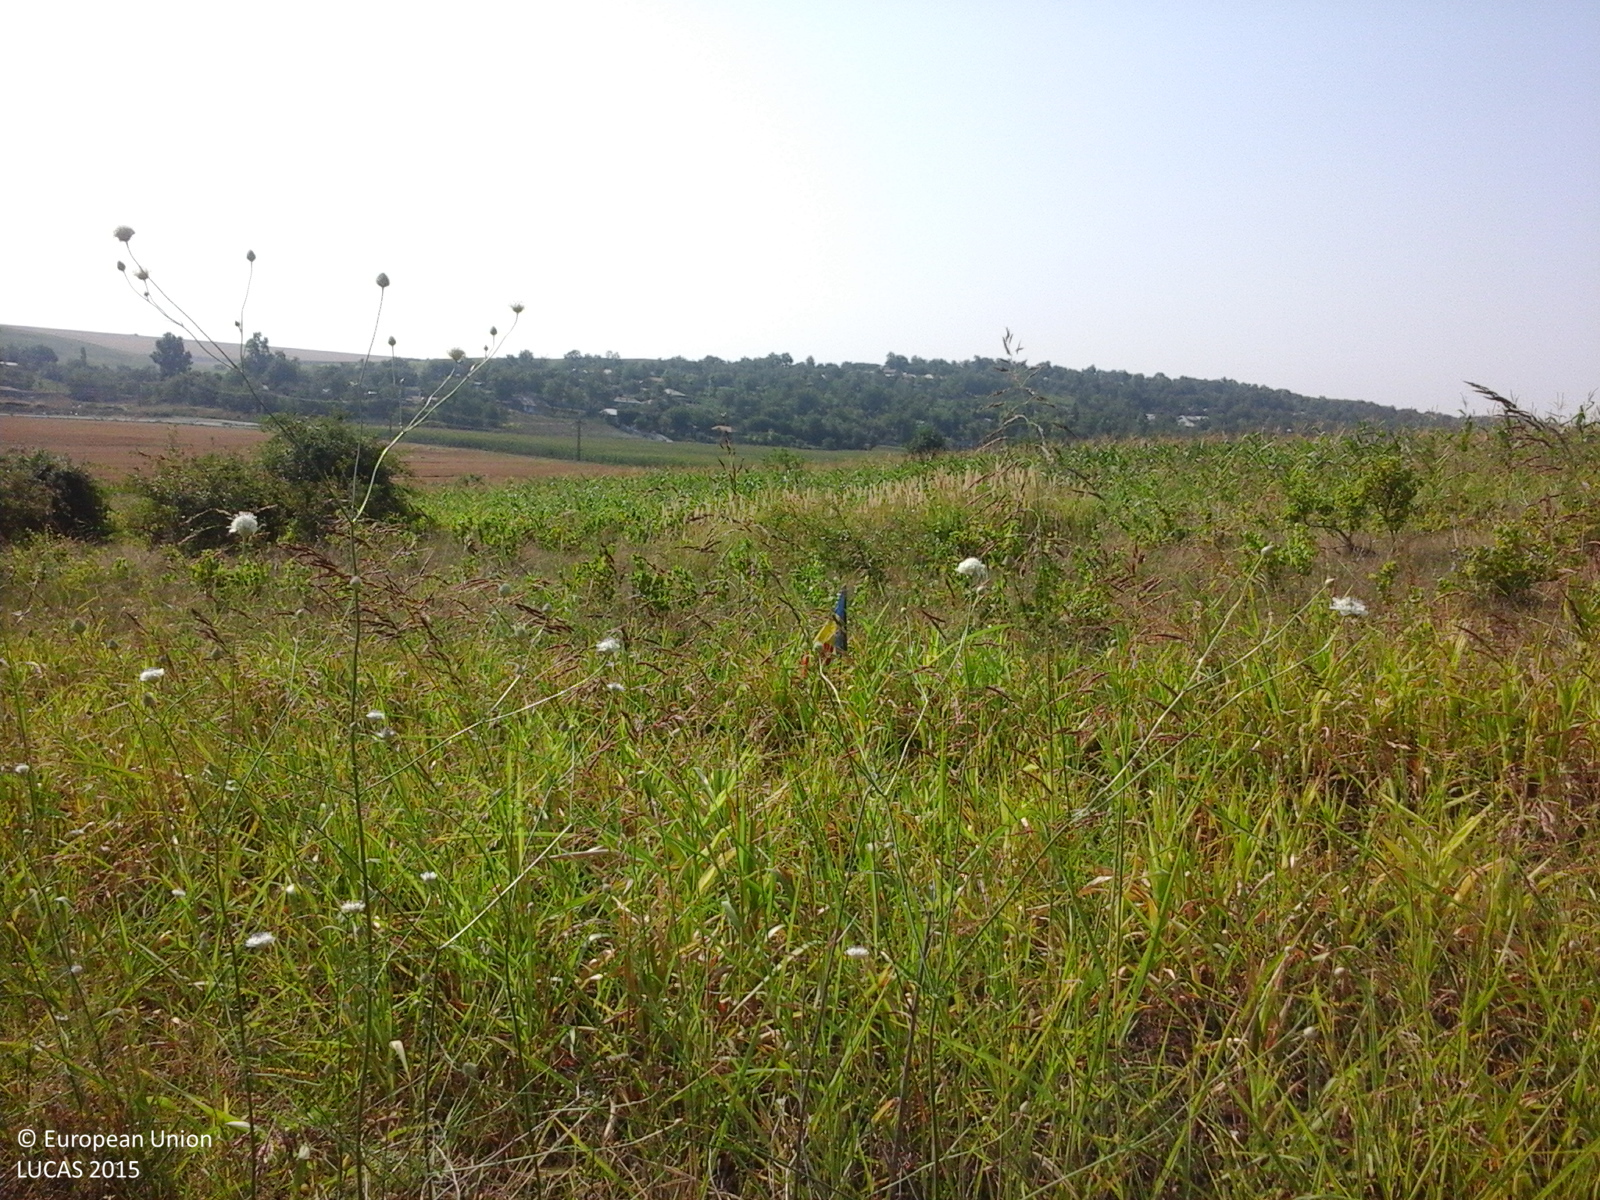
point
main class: Cropland
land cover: Maize
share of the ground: 50 - 75 %
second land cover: Spontaneously vegetated surfaces
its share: 25 - 50 %
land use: Agriculture (excluding fallow land and kitchen gardens)
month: July
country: RO
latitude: 45.7479
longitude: 27.8939
